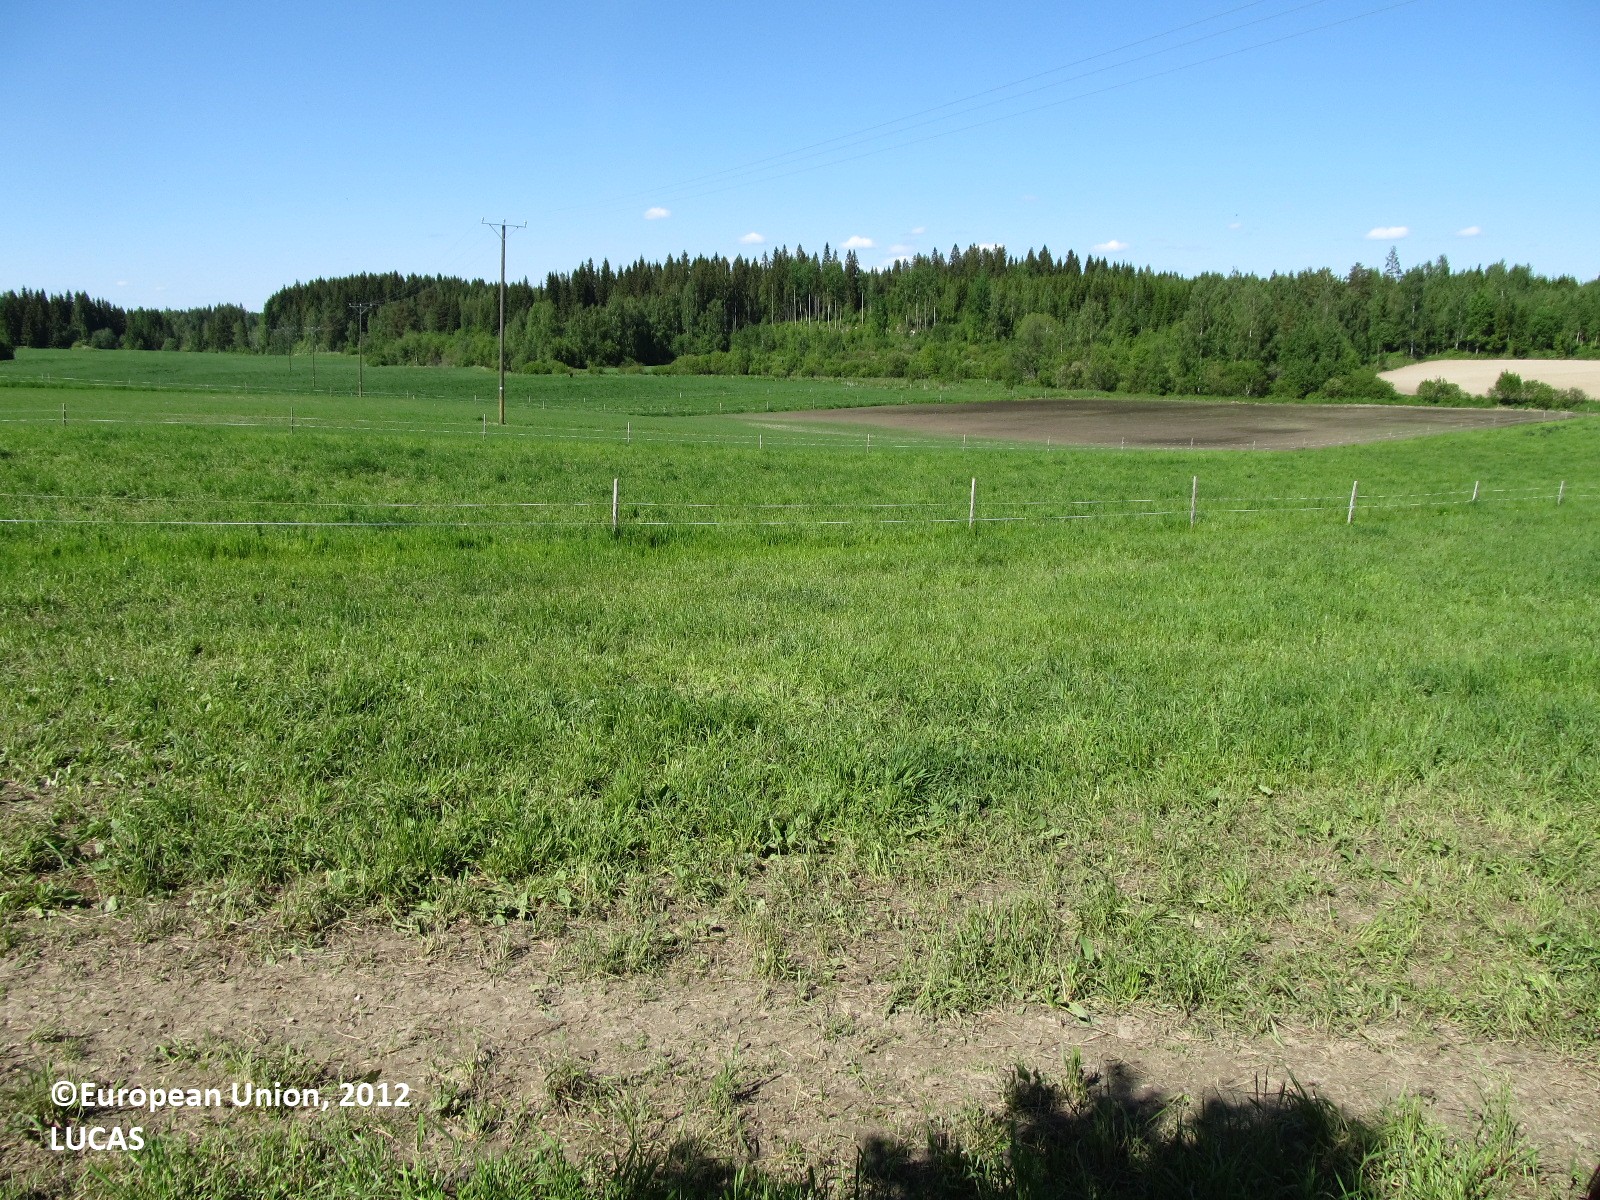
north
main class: Grassland
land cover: Grassland without tree/shrub cover
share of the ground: > 75 %
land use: Agriculture (excluding fallow land and kitchen gardens)
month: June
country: FI
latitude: 63.0323
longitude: 27.5772
